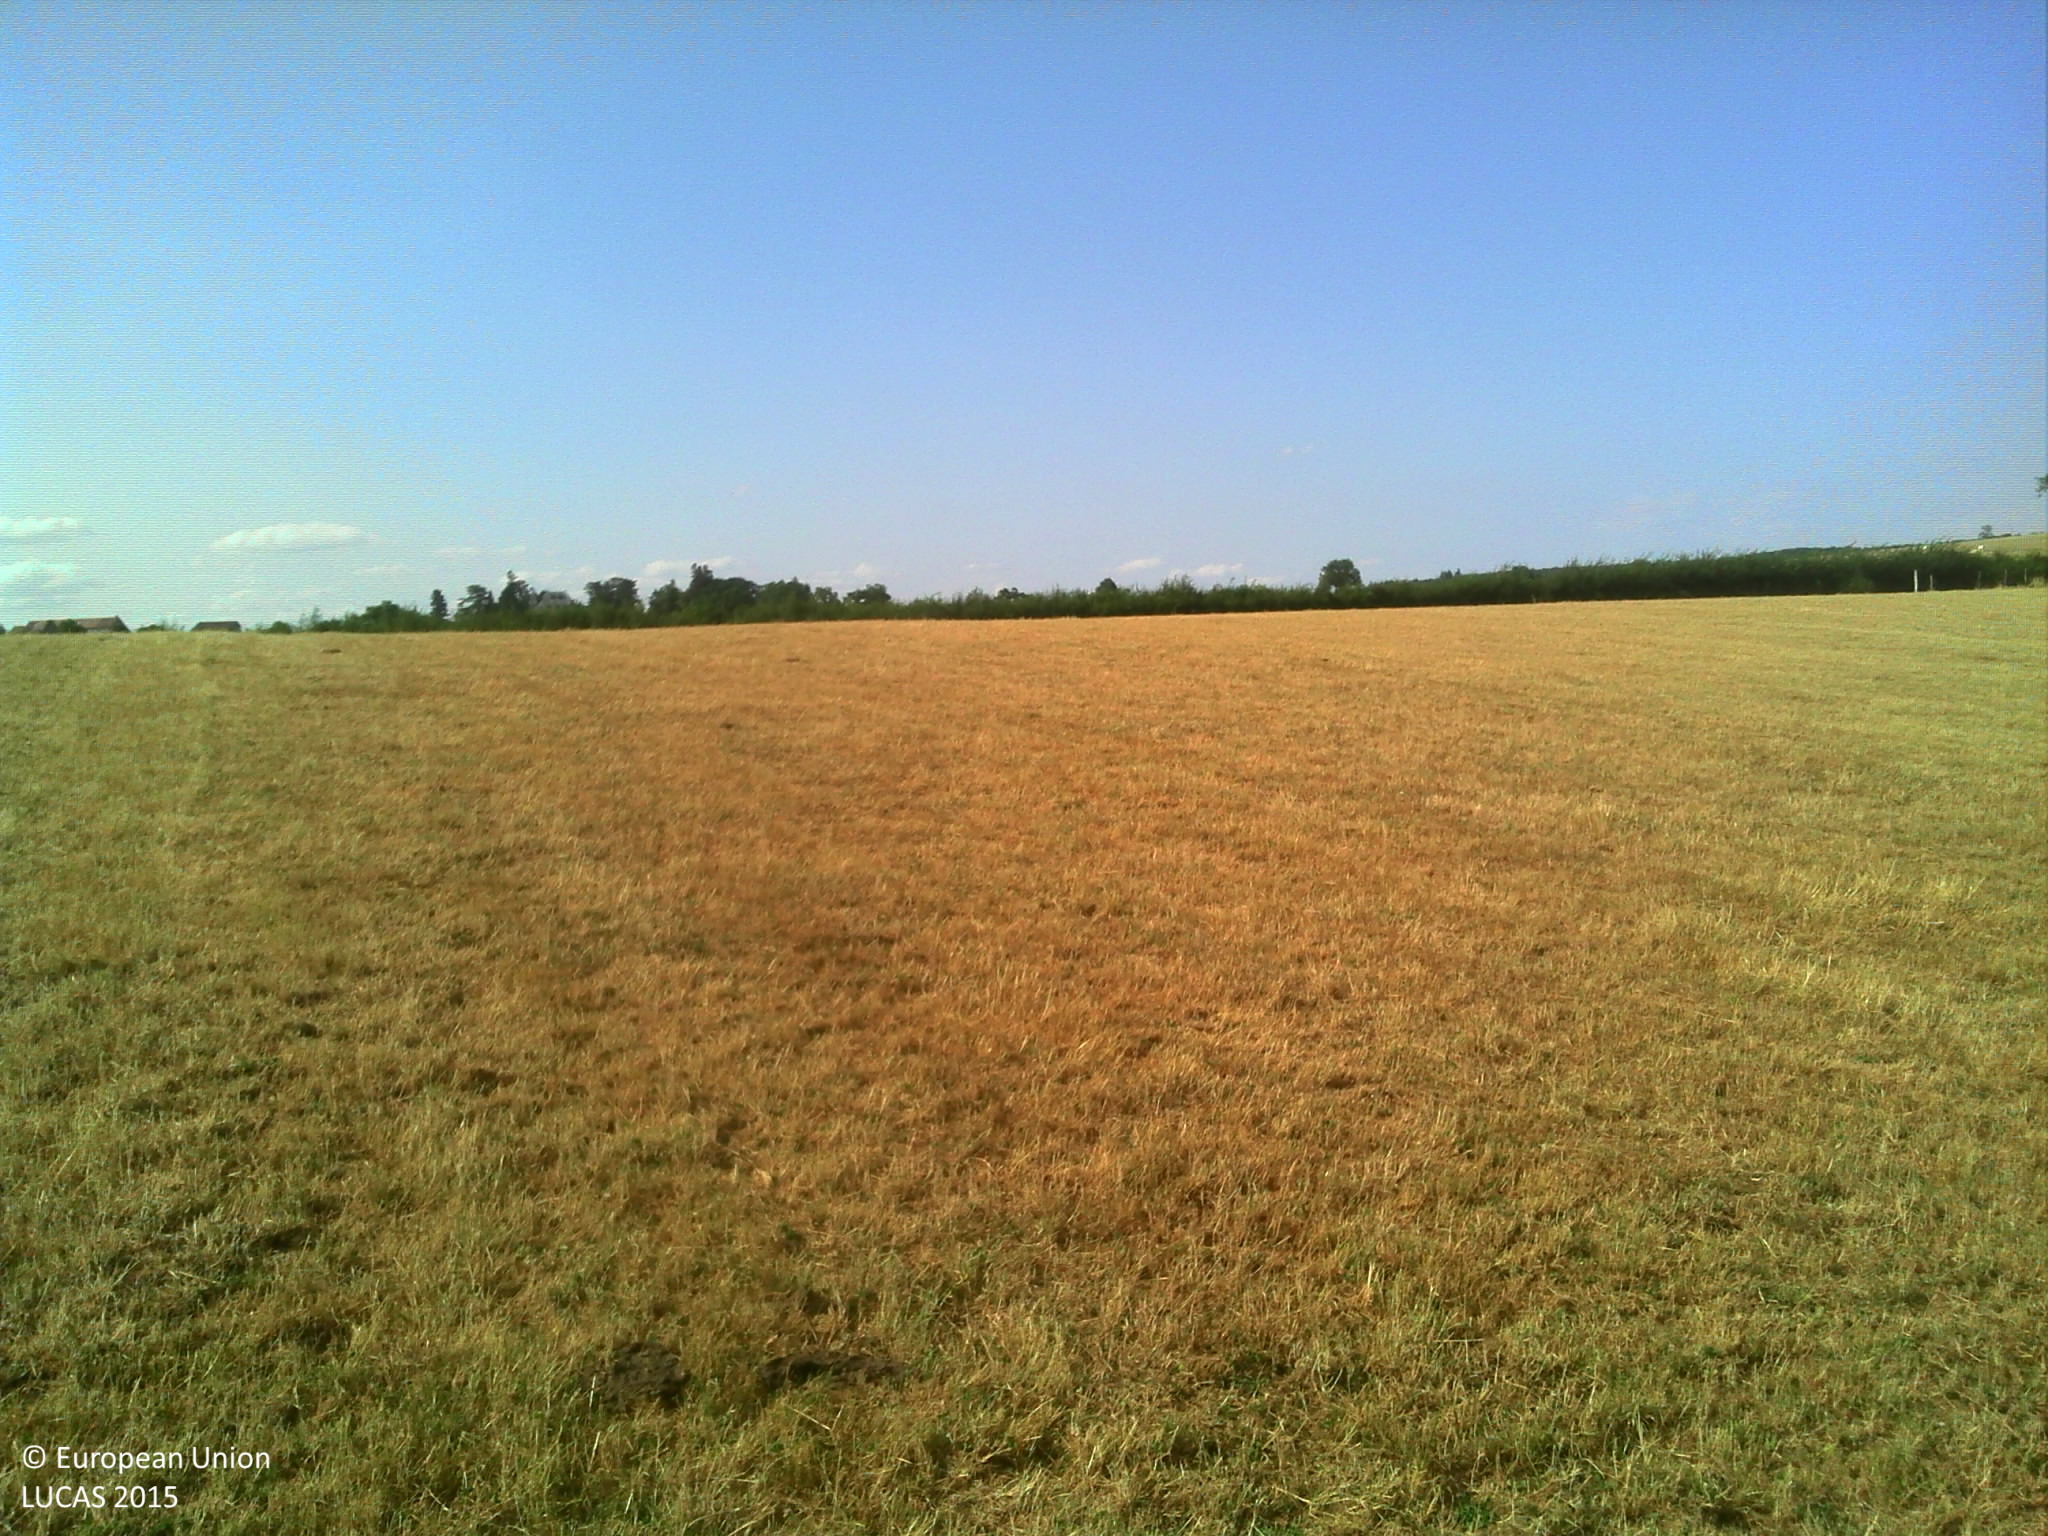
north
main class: Grassland
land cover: Grassland without tree/shrub cover
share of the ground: > 75 %
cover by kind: herbaceous plants 100 %
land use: Agriculture (excluding fallow land and kitchen gardens)
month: July
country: FR
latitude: 46.5837
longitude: 4.4024
